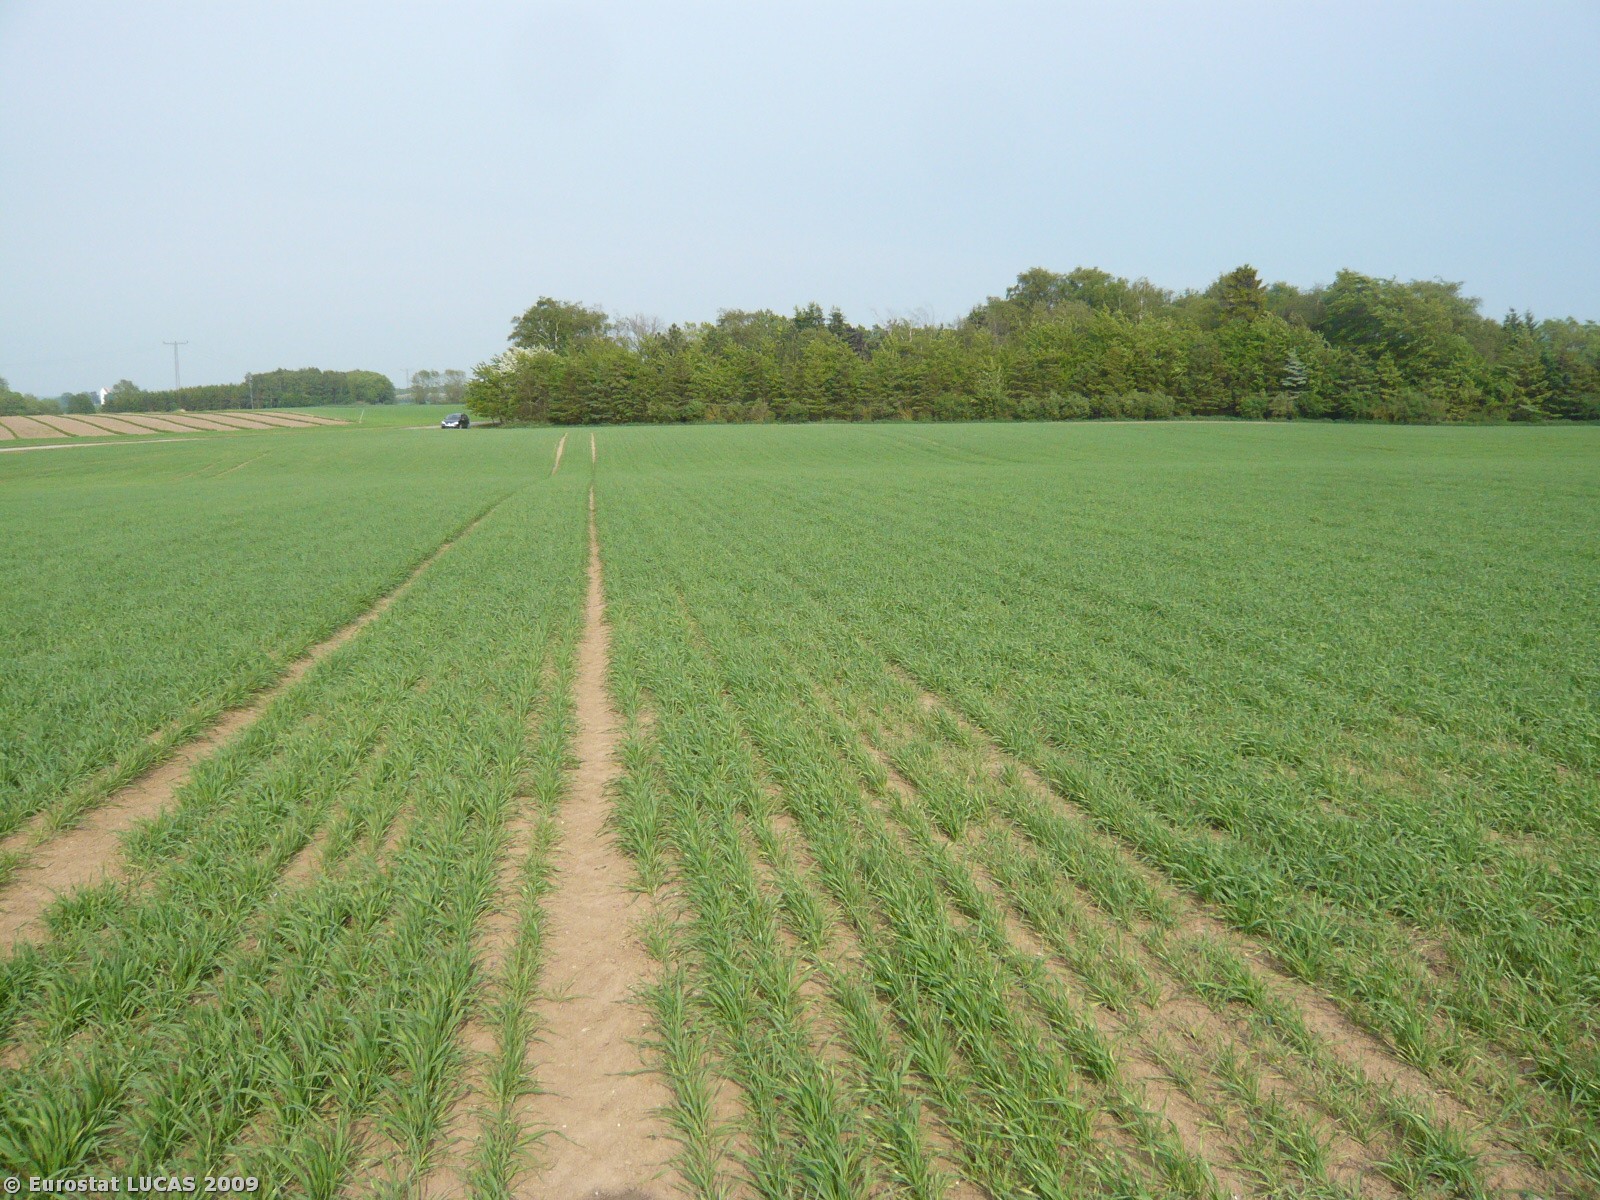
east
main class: Cropland
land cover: Barley
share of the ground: 50 - 75 %
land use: Agriculture (excluding fallow land and kitchen gardens)
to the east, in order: Barley; Broadleaved woodland; Inland water bodies; Artificial constructions in urban areas
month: May
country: DK
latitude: 55.2423
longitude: 11.6501
